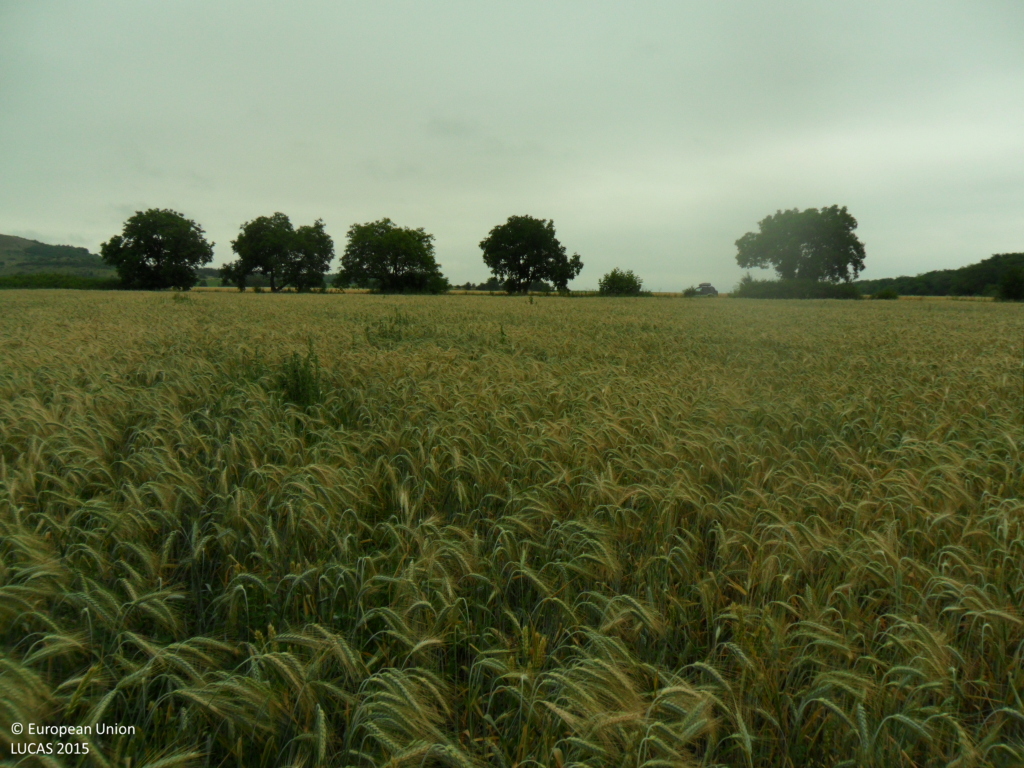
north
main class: Cropland
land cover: Common wheat
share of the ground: > 75 %
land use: Agriculture (excluding fallow land and kitchen gardens)
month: June
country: BG
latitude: 43.3438
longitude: 26.9779
